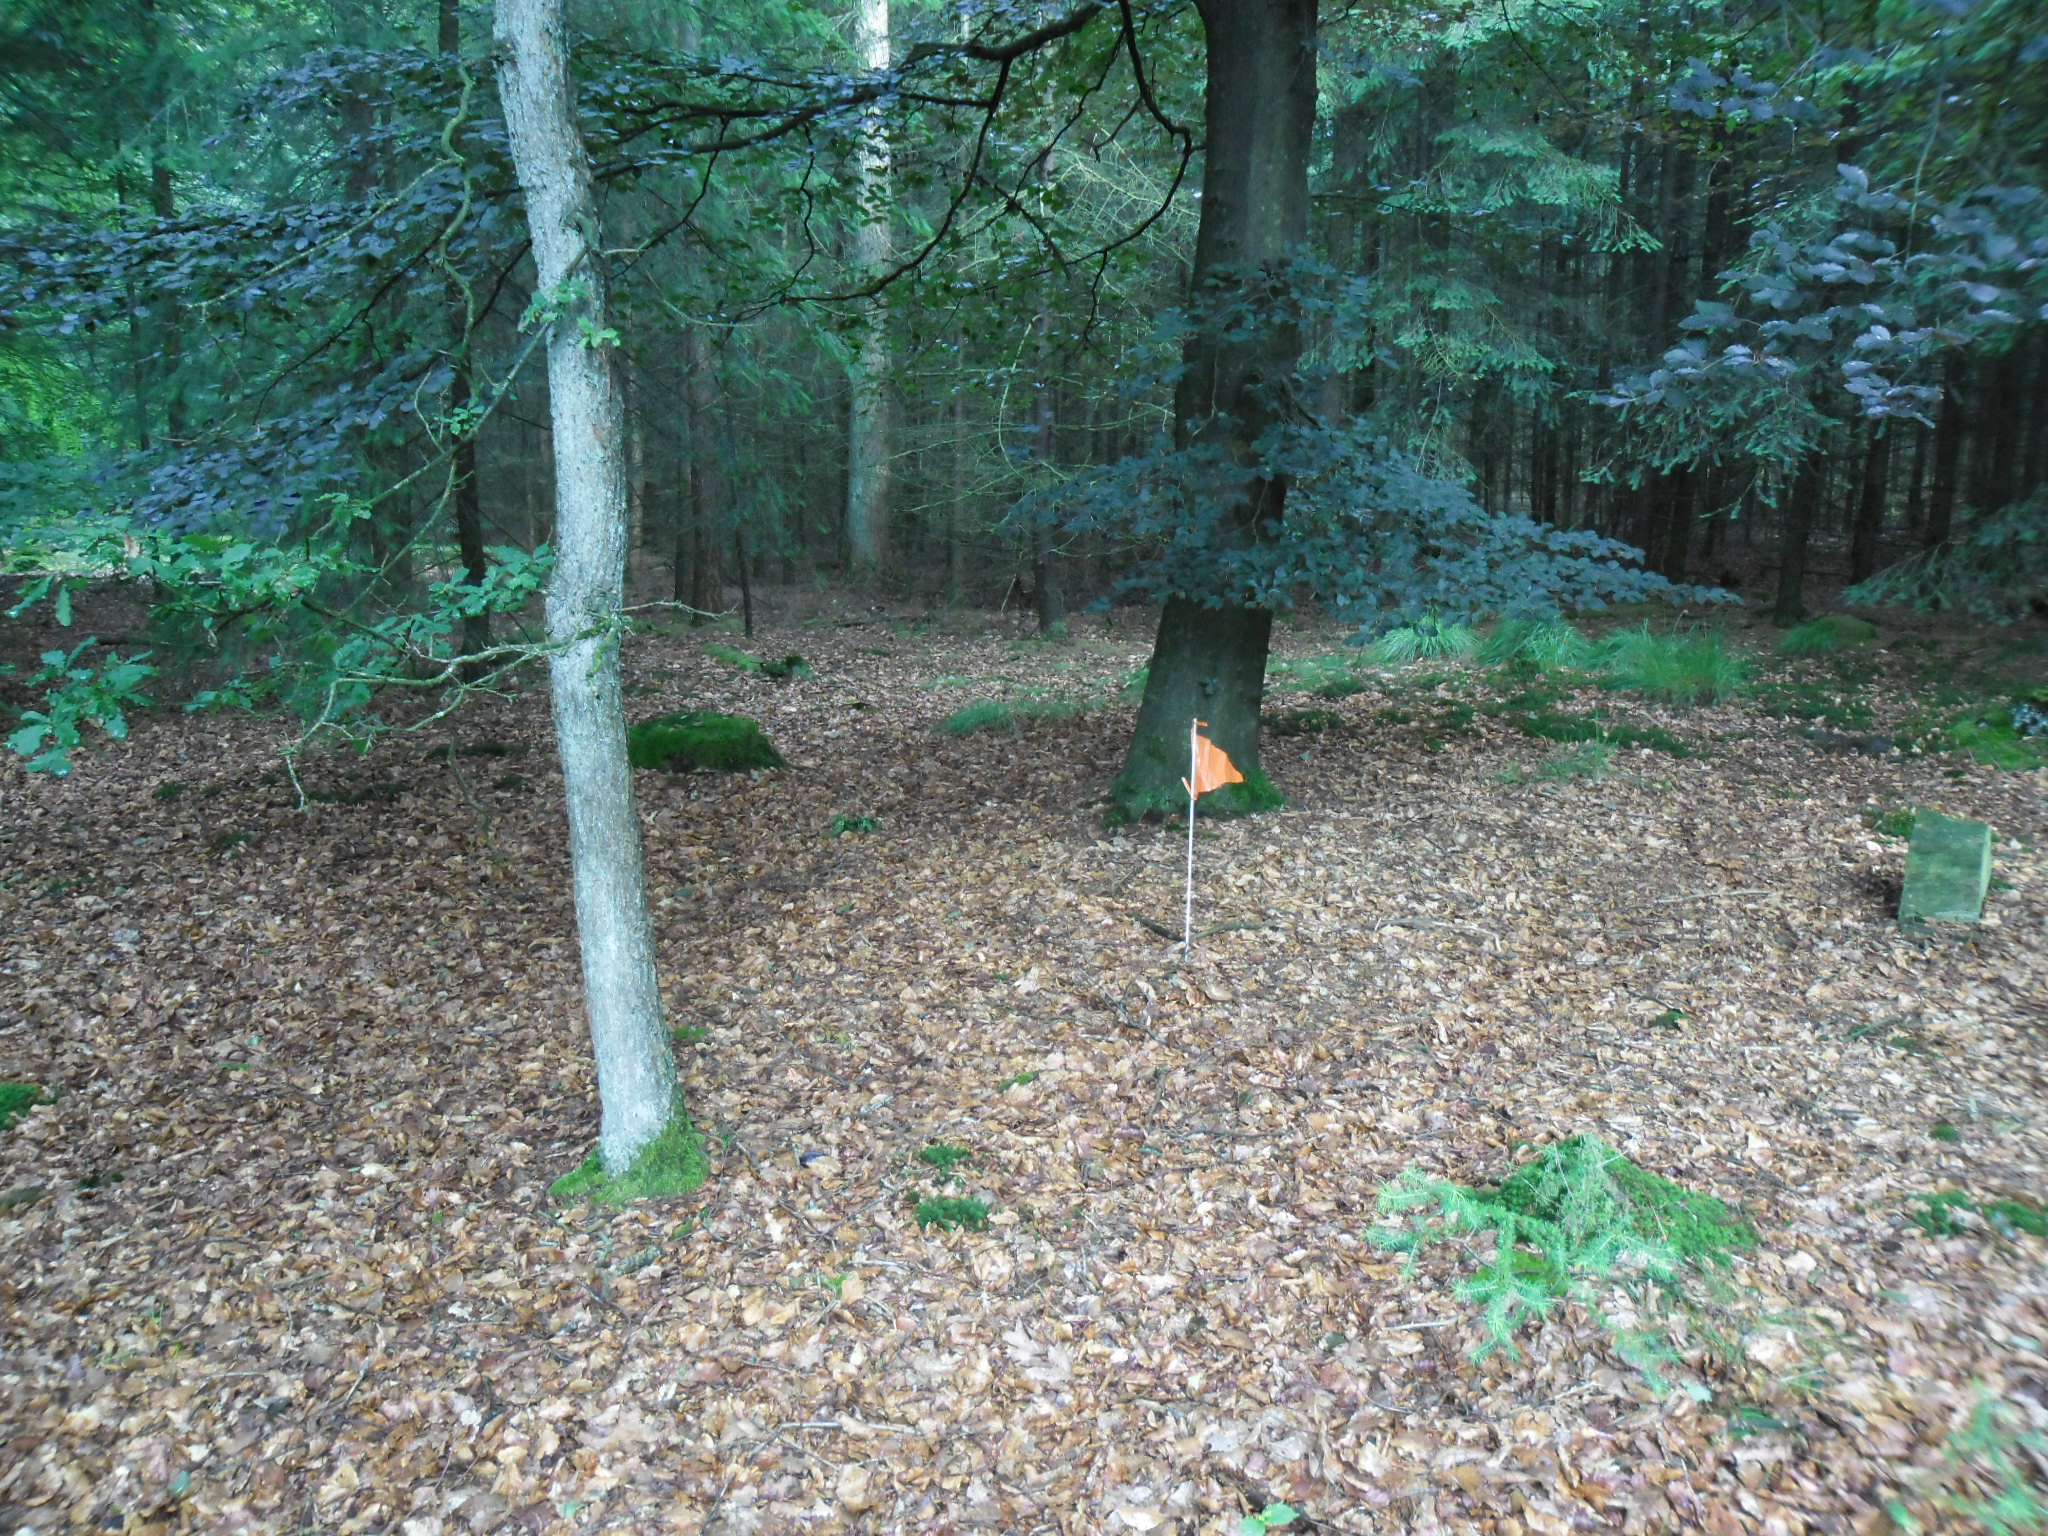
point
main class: Woodland
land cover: Broadleaved woodland
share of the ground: > 75 %
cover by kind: broadleaved forest trees 80 %, coniferous forest trees 20 %
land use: Forestry
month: July
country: NL
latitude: 52.8897
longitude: 6.7155
